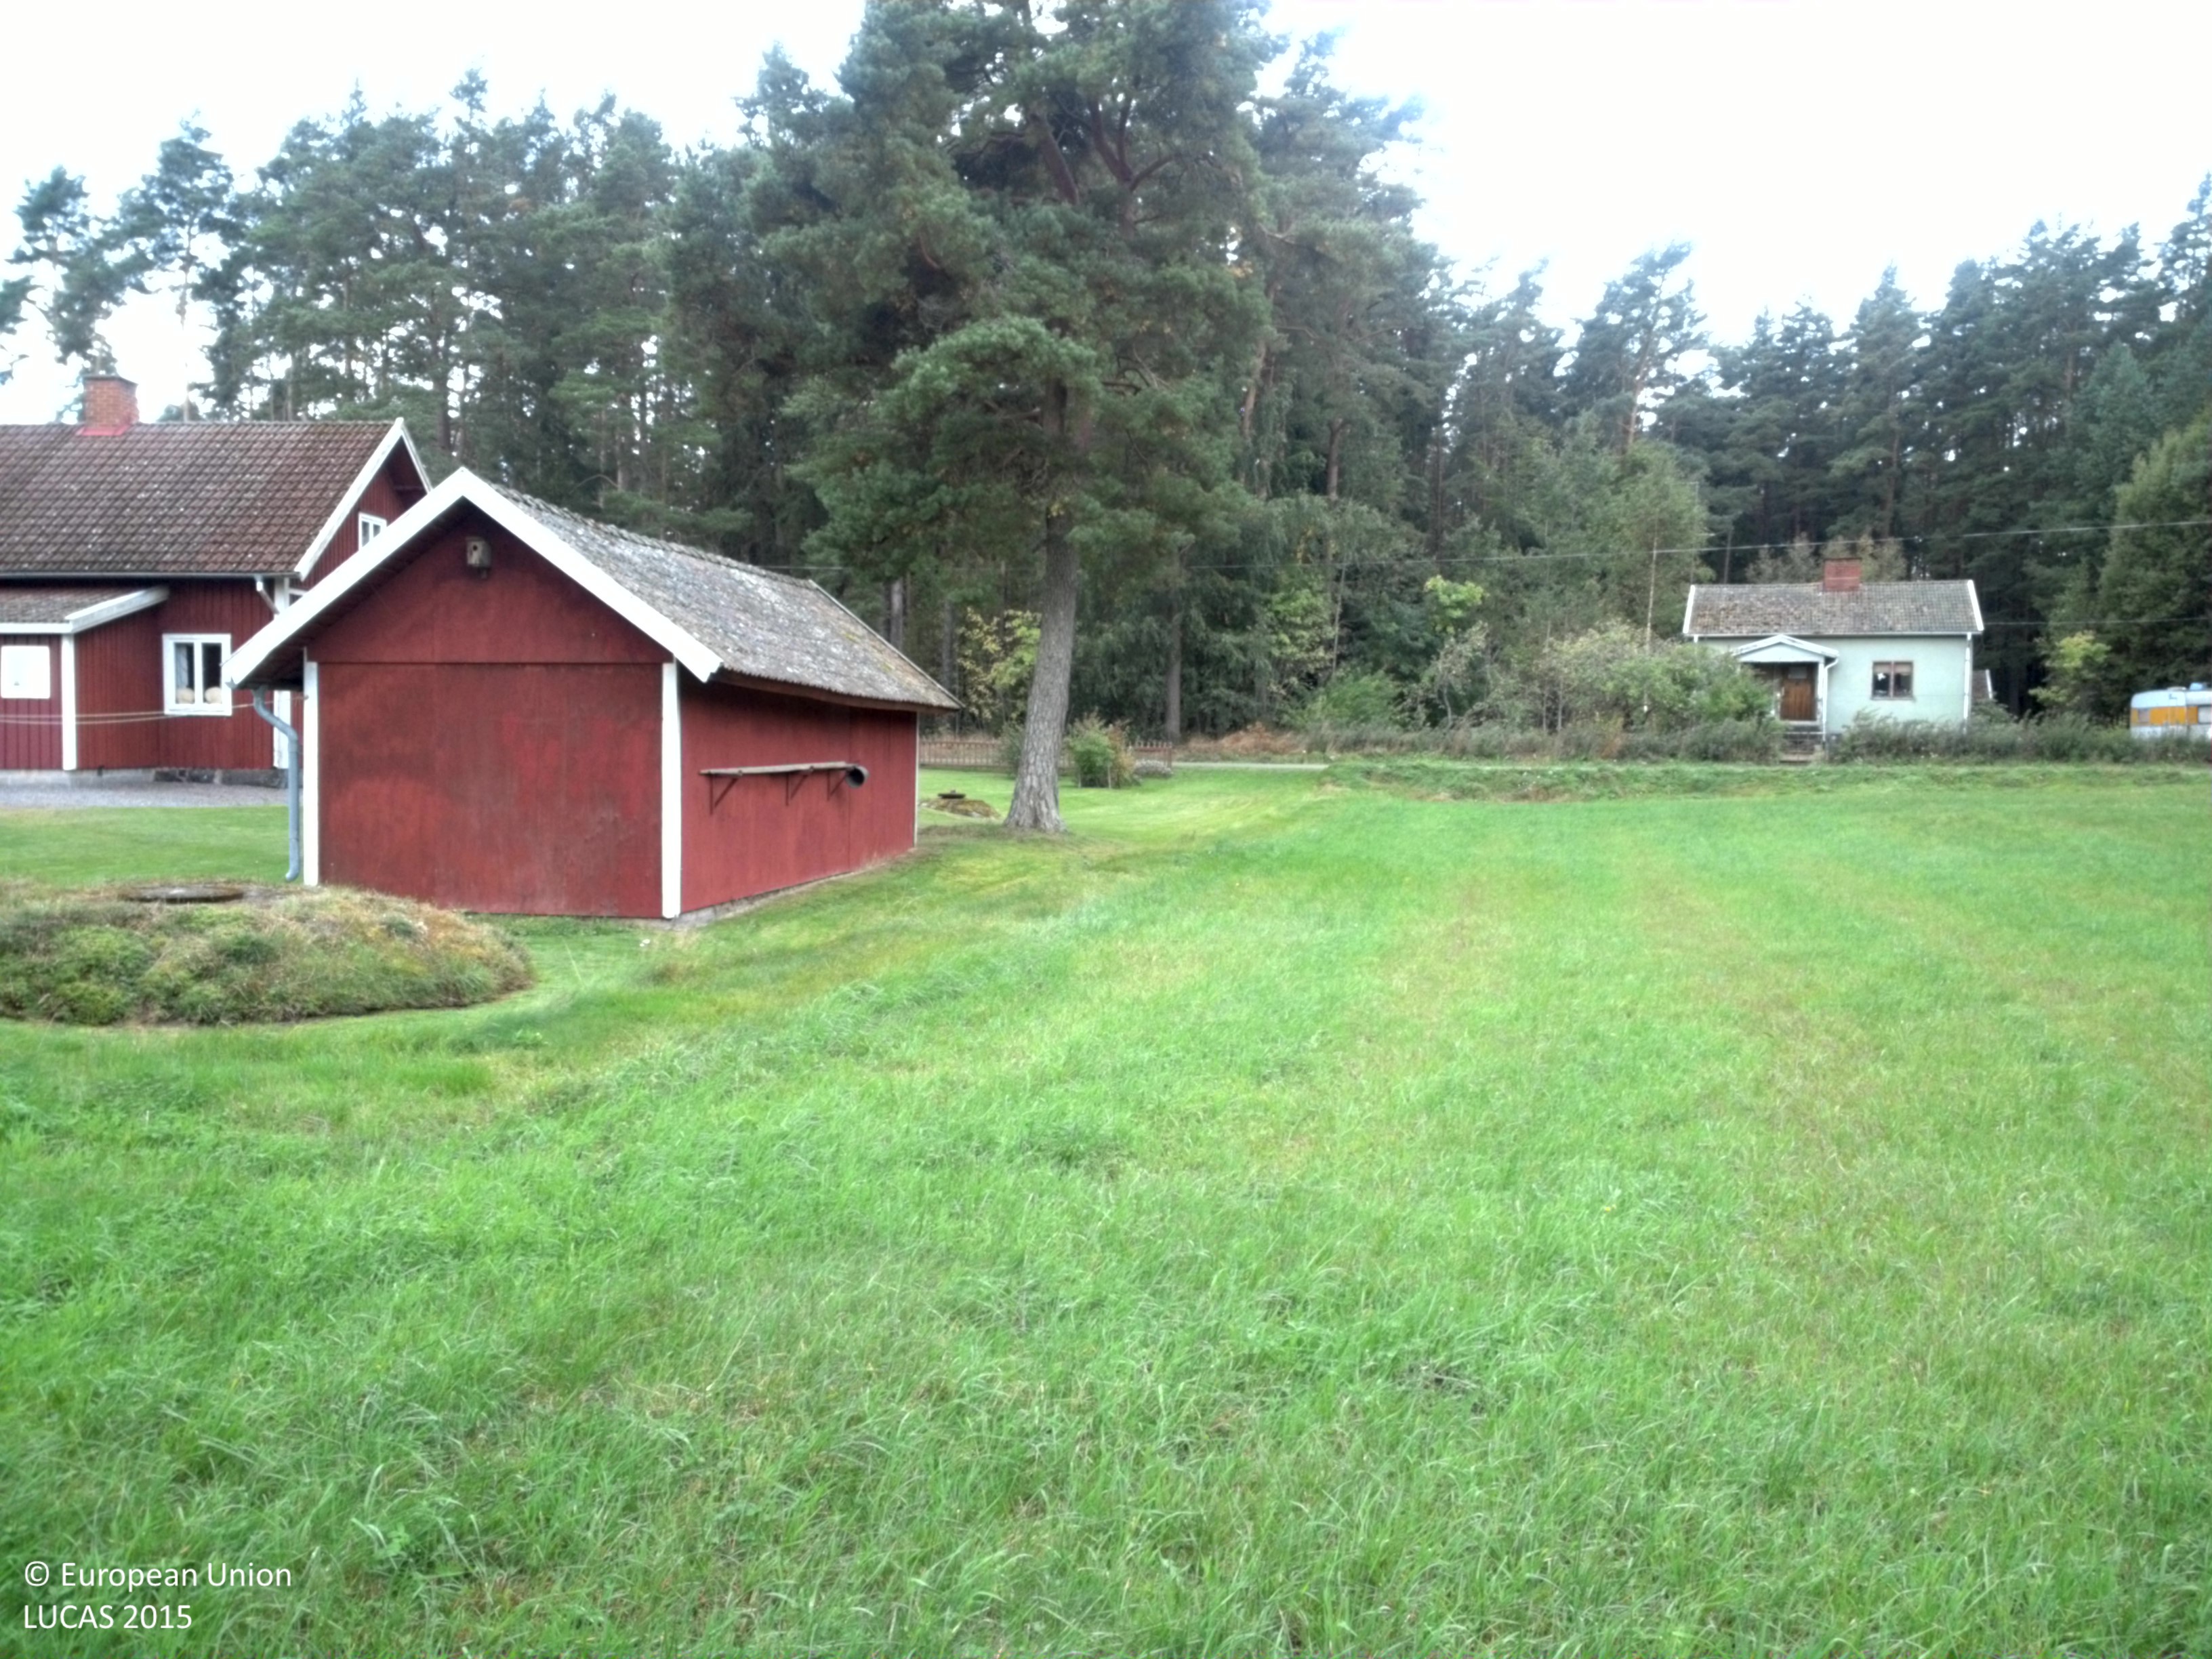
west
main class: Cropland
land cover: Temporary grasslands
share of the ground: > 75 %
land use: Agriculture (excluding fallow land and kitchen gardens)
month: September
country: SE
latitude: 59.0042
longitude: 14.0837
